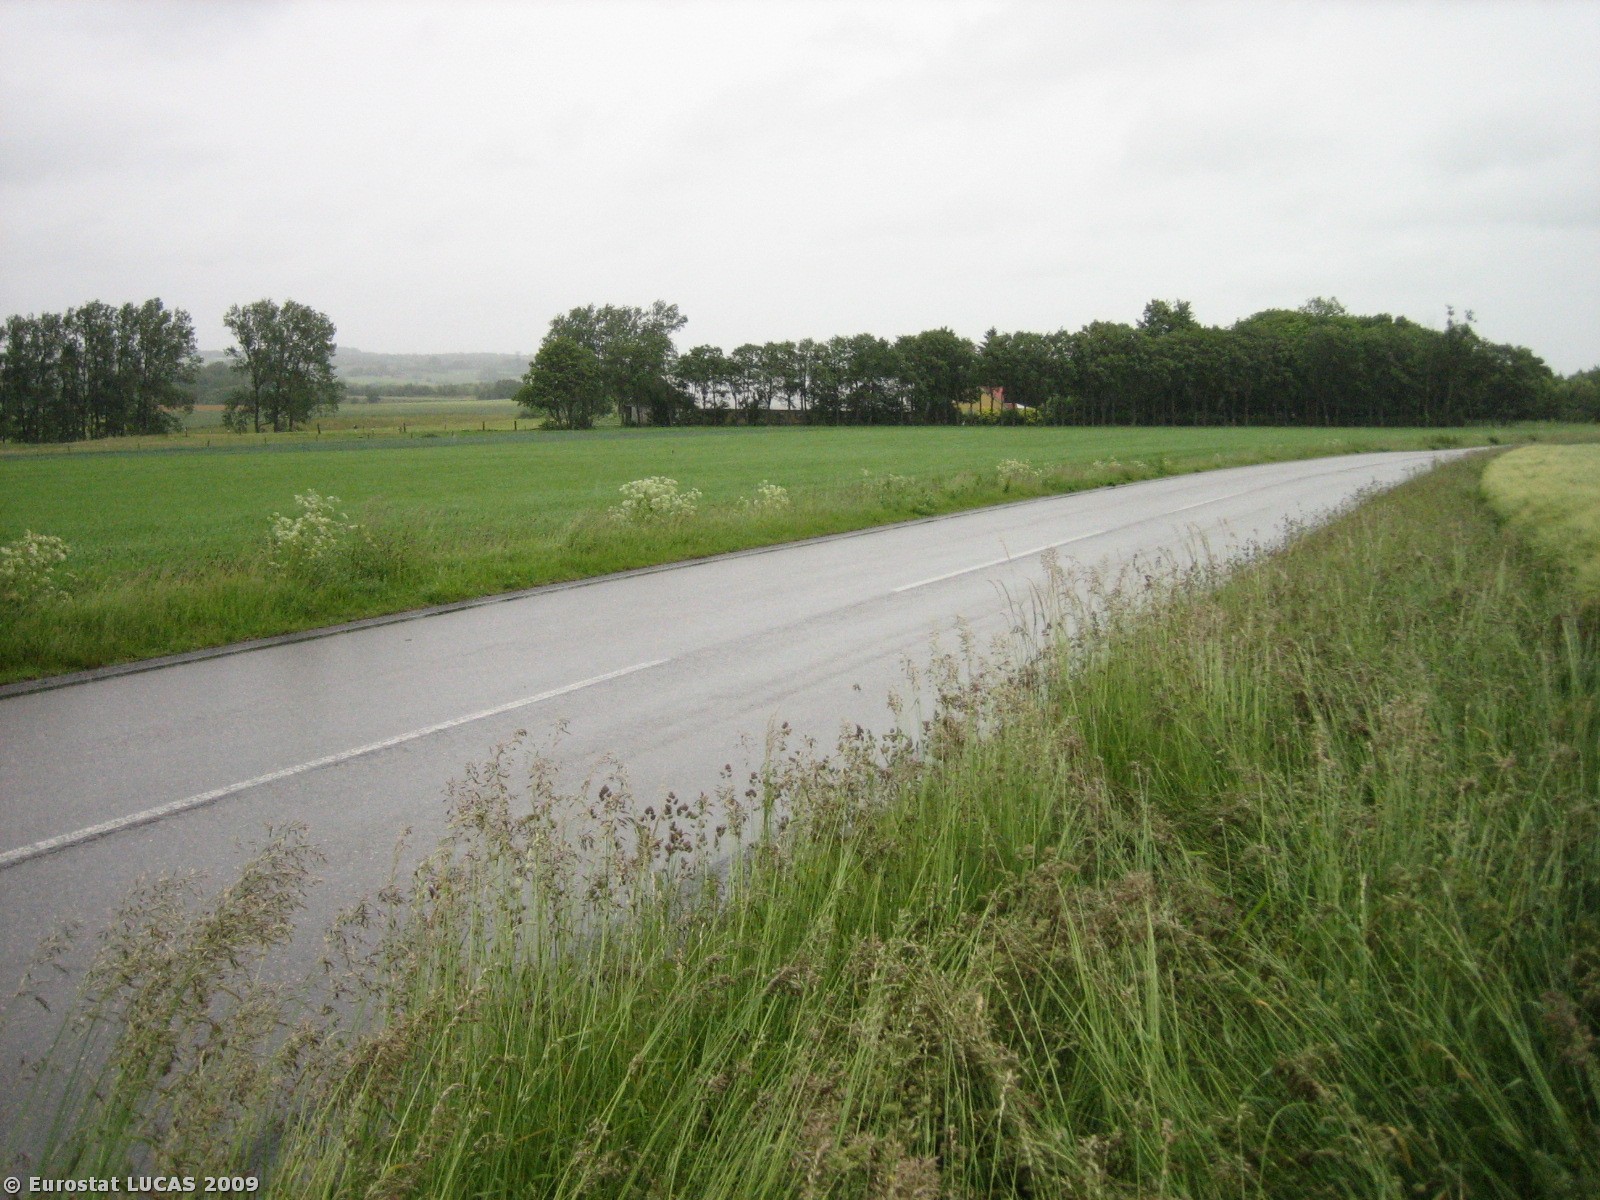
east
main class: Cropland
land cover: Rape and turnip rape
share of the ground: > 75 %
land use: Agriculture (excluding fallow land and kitchen gardens)
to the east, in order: Rape and turnip rape; Common wheat; Grass margins; Paved roads, cycling and walking lanes; Grass margins; Barley; Grass margins; Lines of trees; Grassland without tree/shrub cover; Tracks; Grass margins; Broadleaved woodland
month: June
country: DK
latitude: 56.0979
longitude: 10.0161
